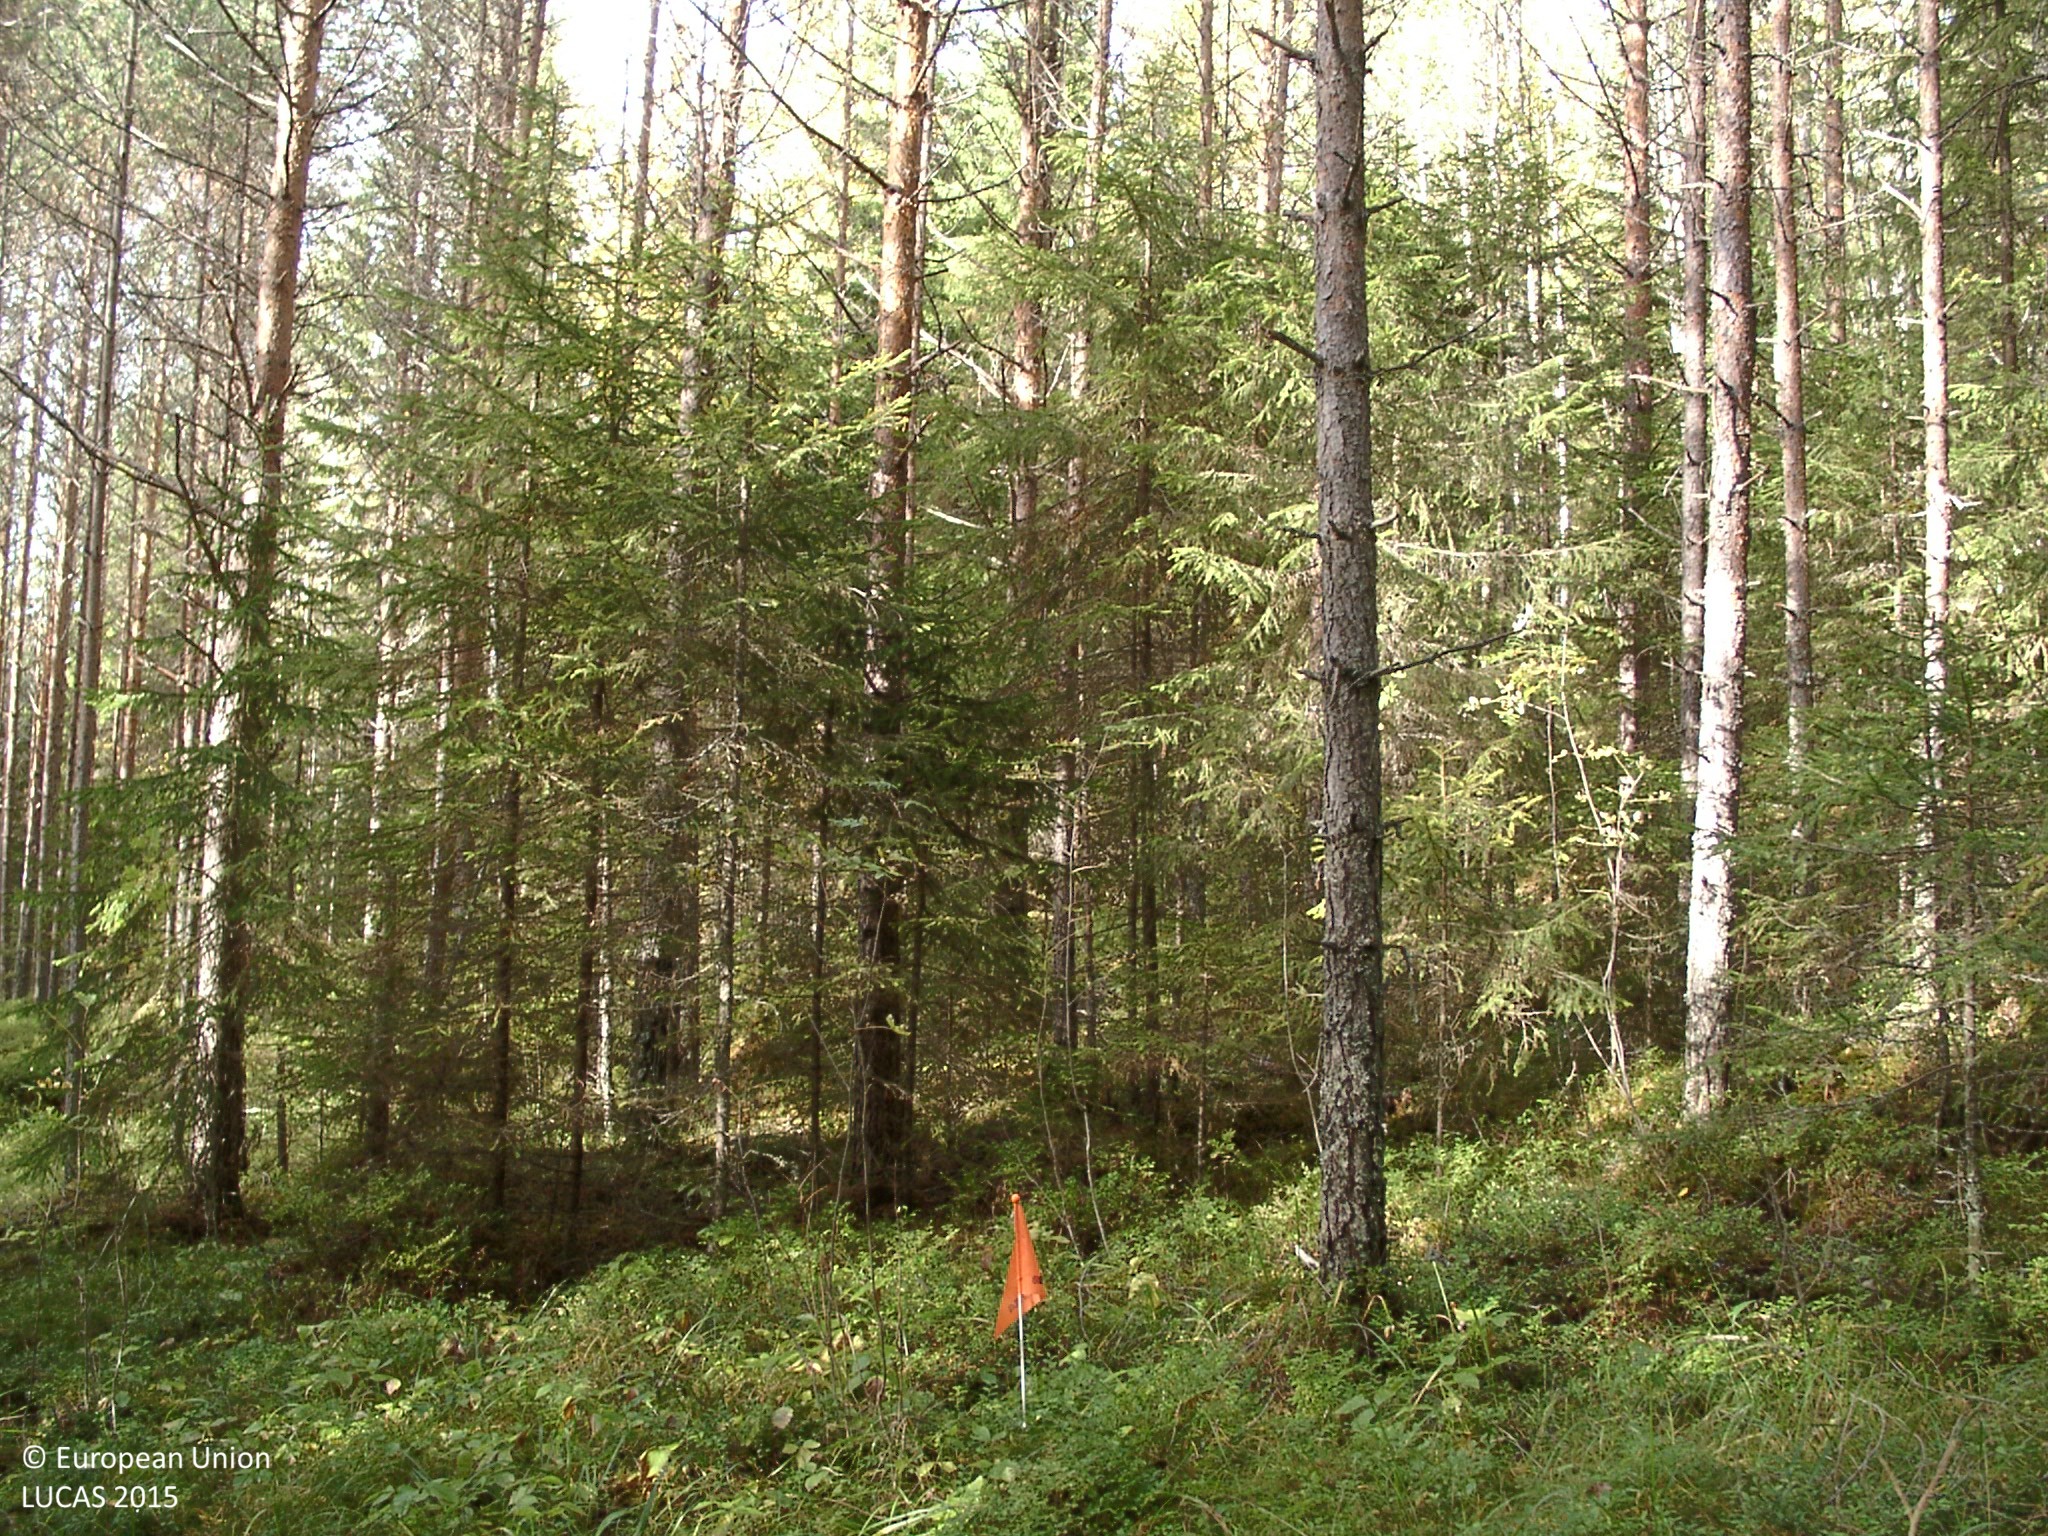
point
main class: Woodland
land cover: Other coniferous woodland
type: boreal forest
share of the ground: > 75 %
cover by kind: coniferous forest trees 80 %, shrubs 10 %, herbaceous plants 5 %, lichens and mosses 5 %
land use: Forestry
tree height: > 5 m
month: September
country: FI
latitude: 62.5611
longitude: 25.2987
